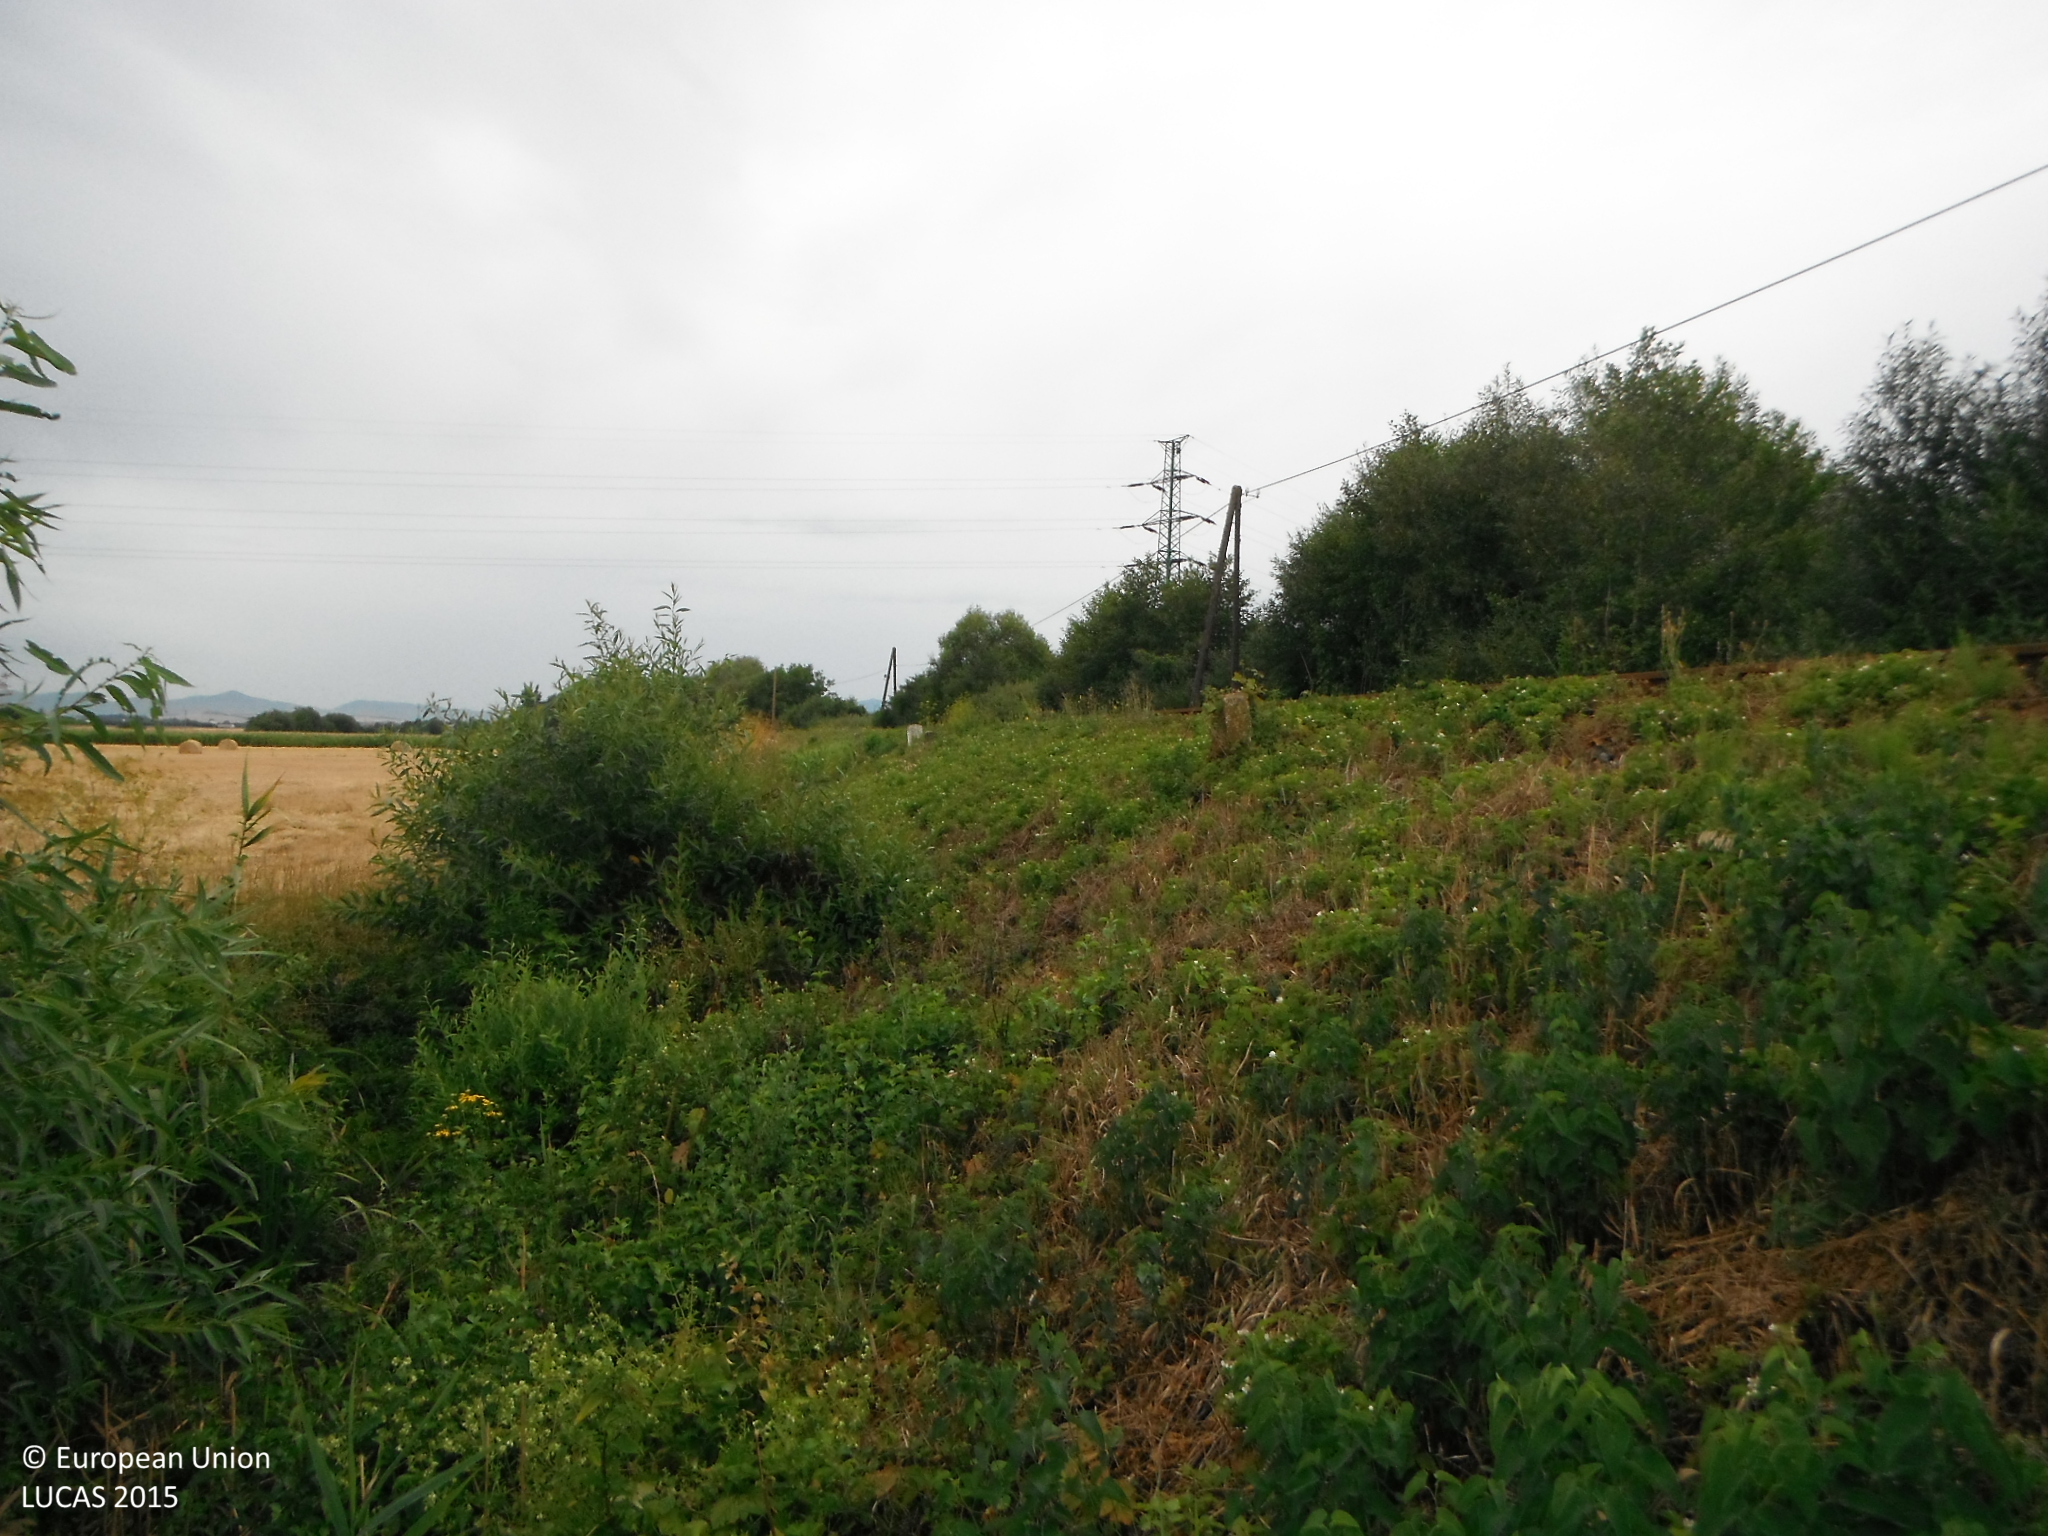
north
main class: Shrubland
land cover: Shrubland with sparse tree cover
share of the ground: > 75 %
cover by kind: shrubs 95 %, broadleaved forest trees 5 %
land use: Semi-natural and natural areas not in use
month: July
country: SK
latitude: 48.6352
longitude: 18.2796
